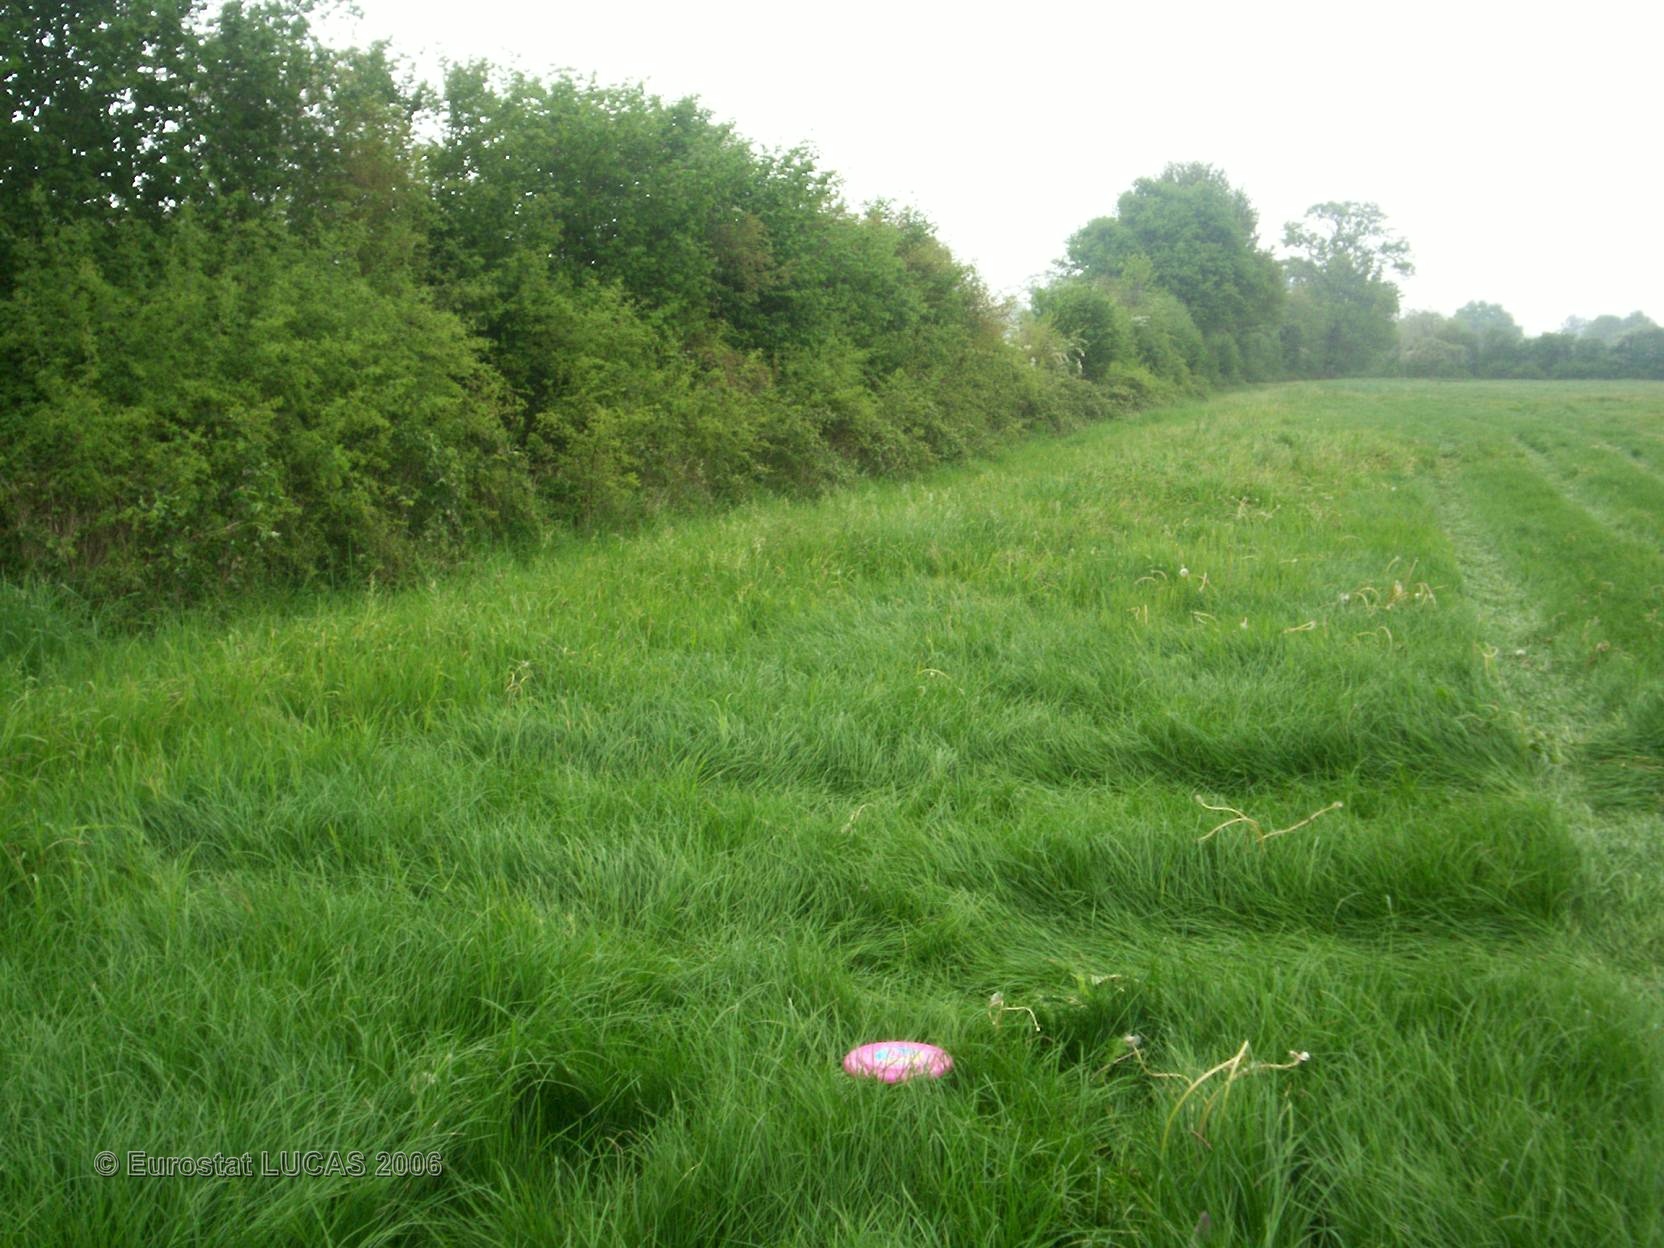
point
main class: Grassland
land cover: Grassland without tree/shrub cover
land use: Agriculture (excluding fallow land and kitchen gardens)
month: May
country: FR
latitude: 47.9489
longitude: 0.4026
